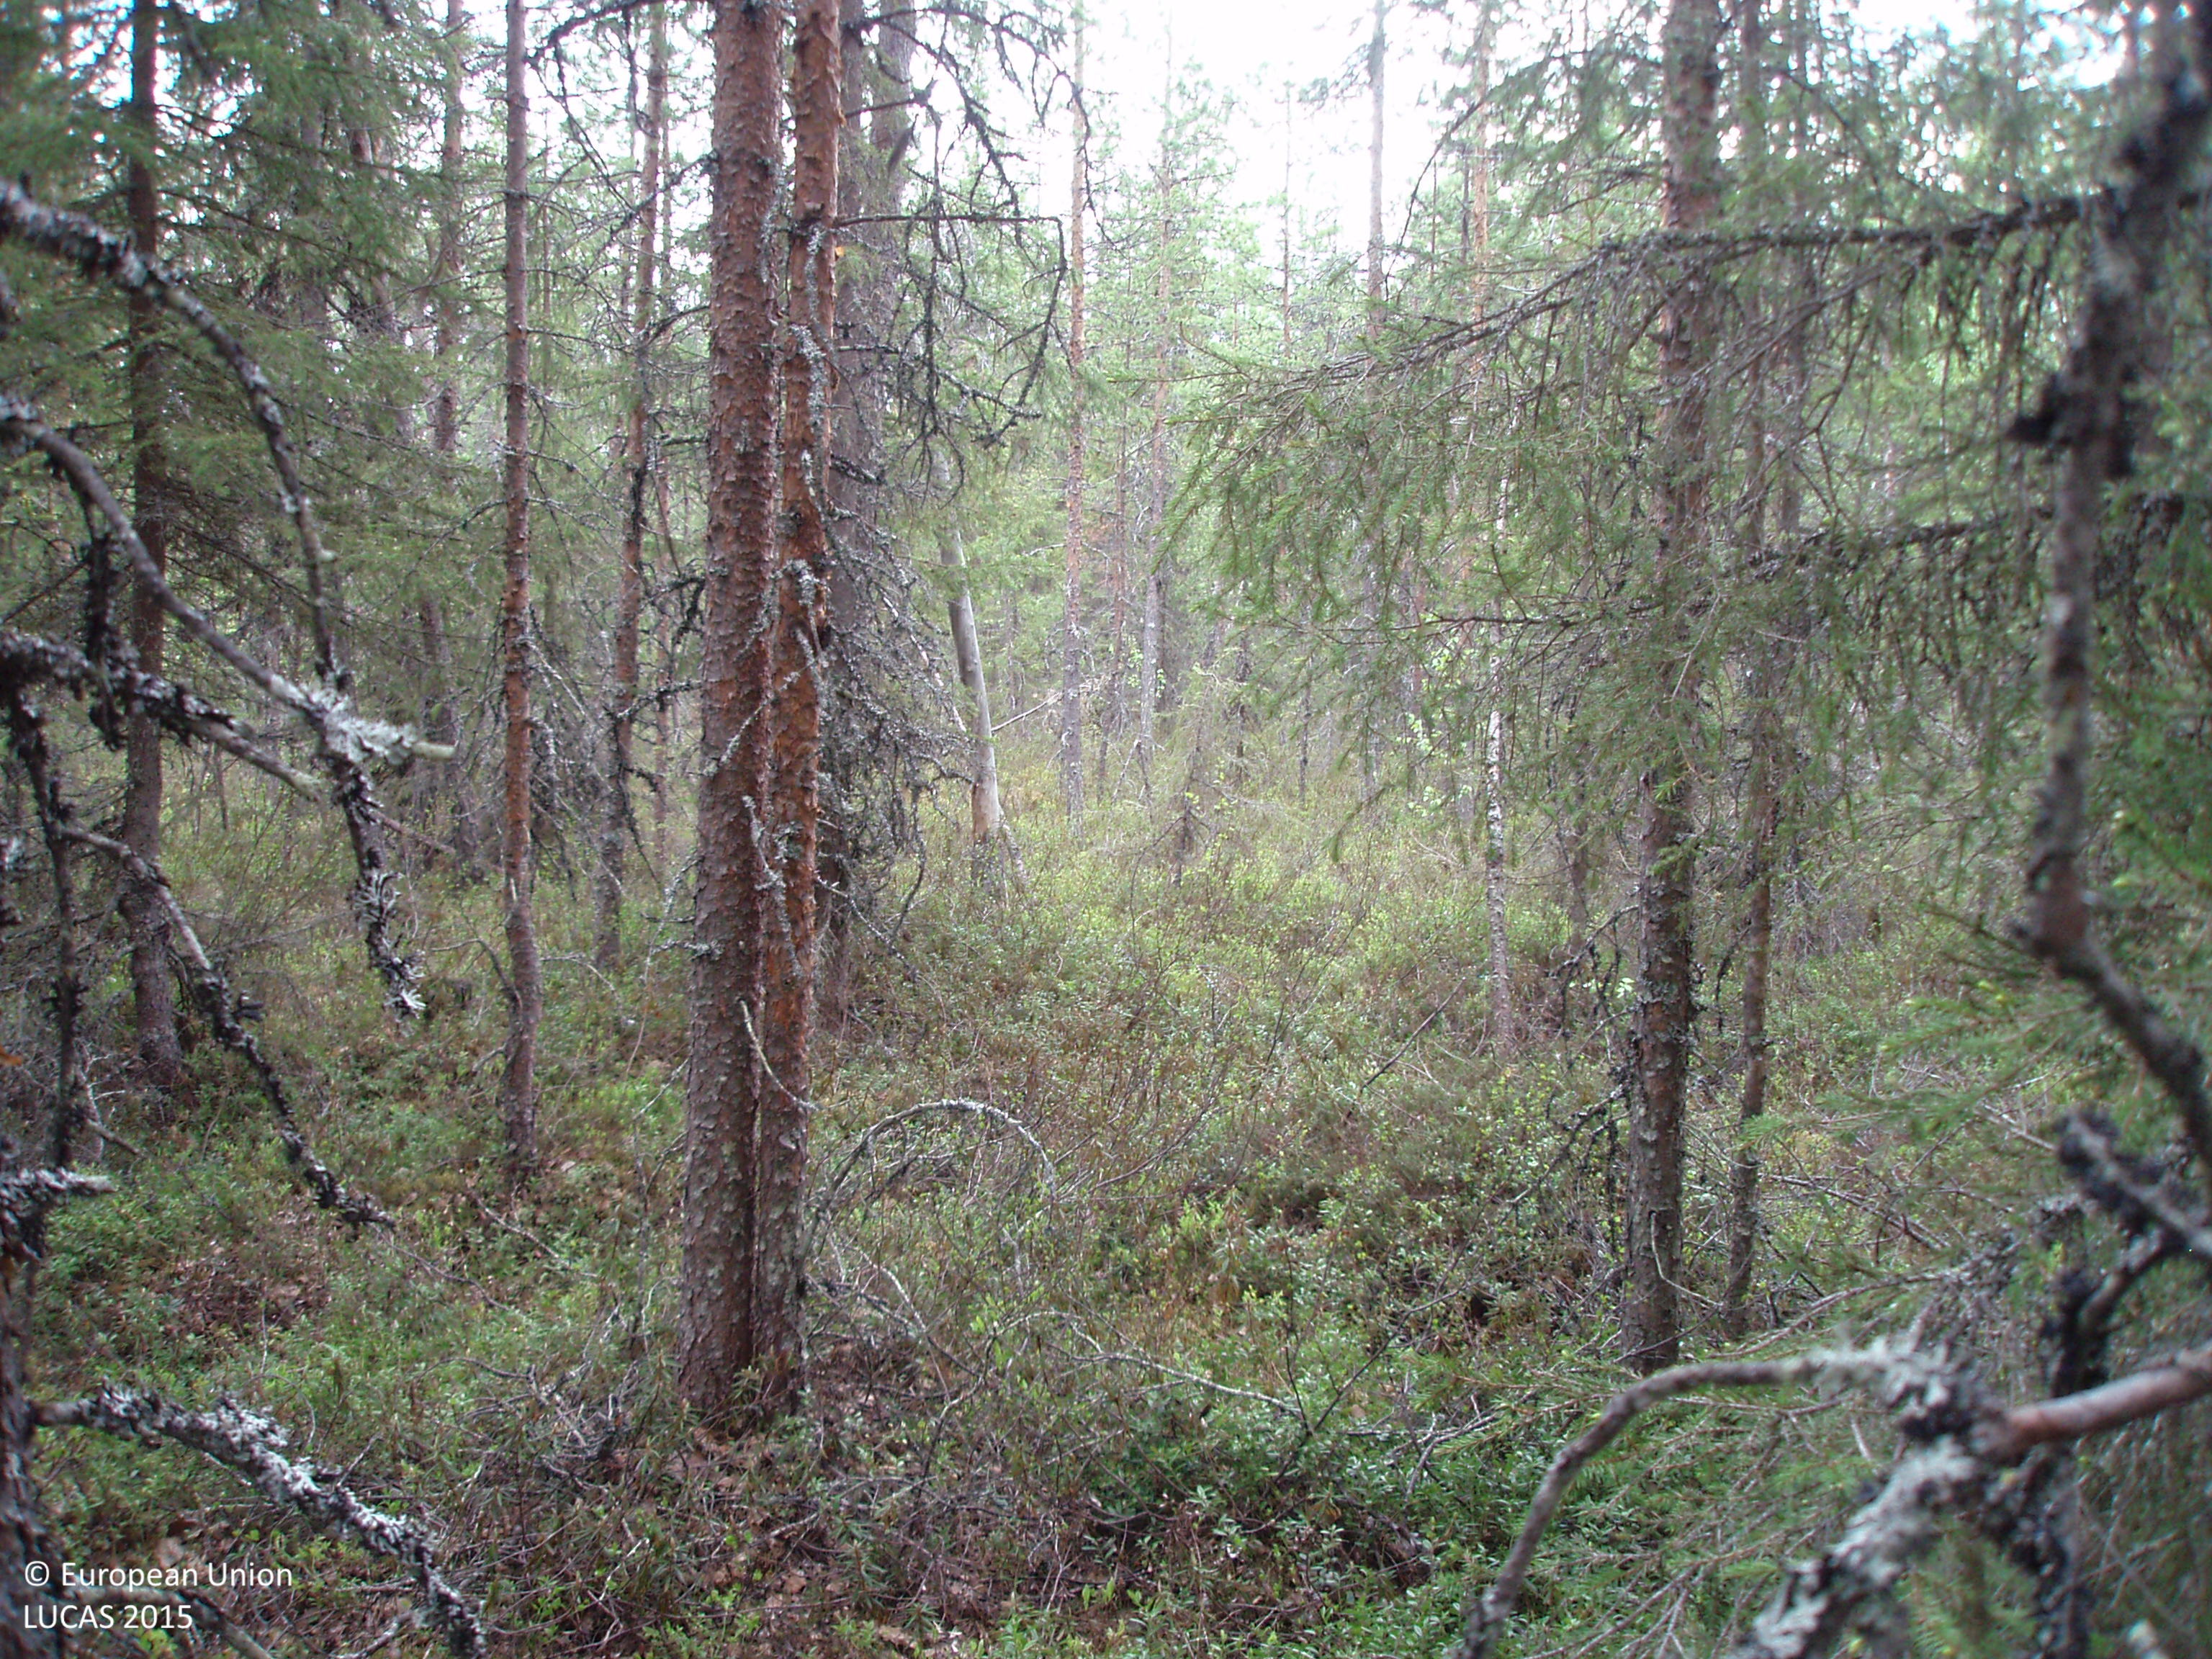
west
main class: Woodland
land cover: Other mixed woodland
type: boreal forest
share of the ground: > 75 %
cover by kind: broadleaved forest trees 50 %, coniferous forest trees 40 %, shrubs 5 %, herbaceous plants 5 %
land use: Forestry
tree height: > 5 m
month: June
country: FI
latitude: 67.2589
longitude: 27.2728
